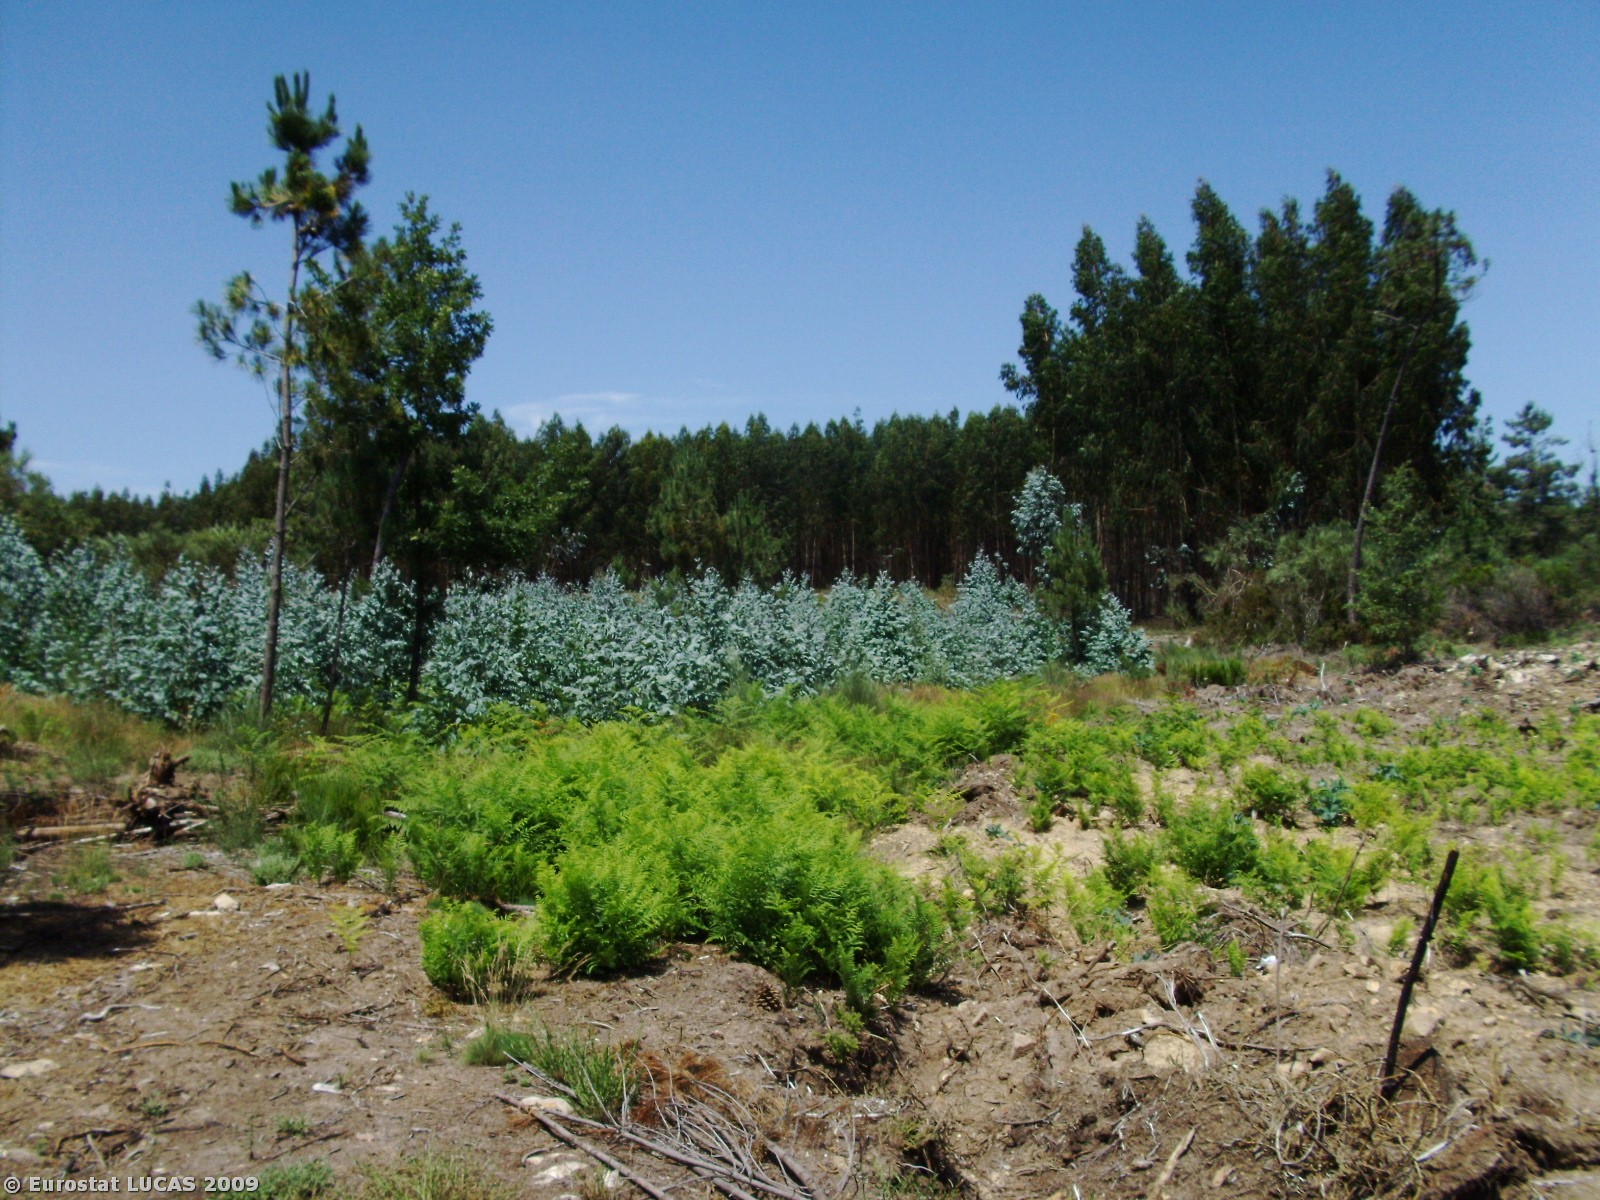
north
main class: Woodland
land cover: Broadleaved woodland
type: mesophytic deciduous forest
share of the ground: 25 - 50 %
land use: Forestry
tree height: > 5 m
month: July
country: PT
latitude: 40.8956
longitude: -7.7019
